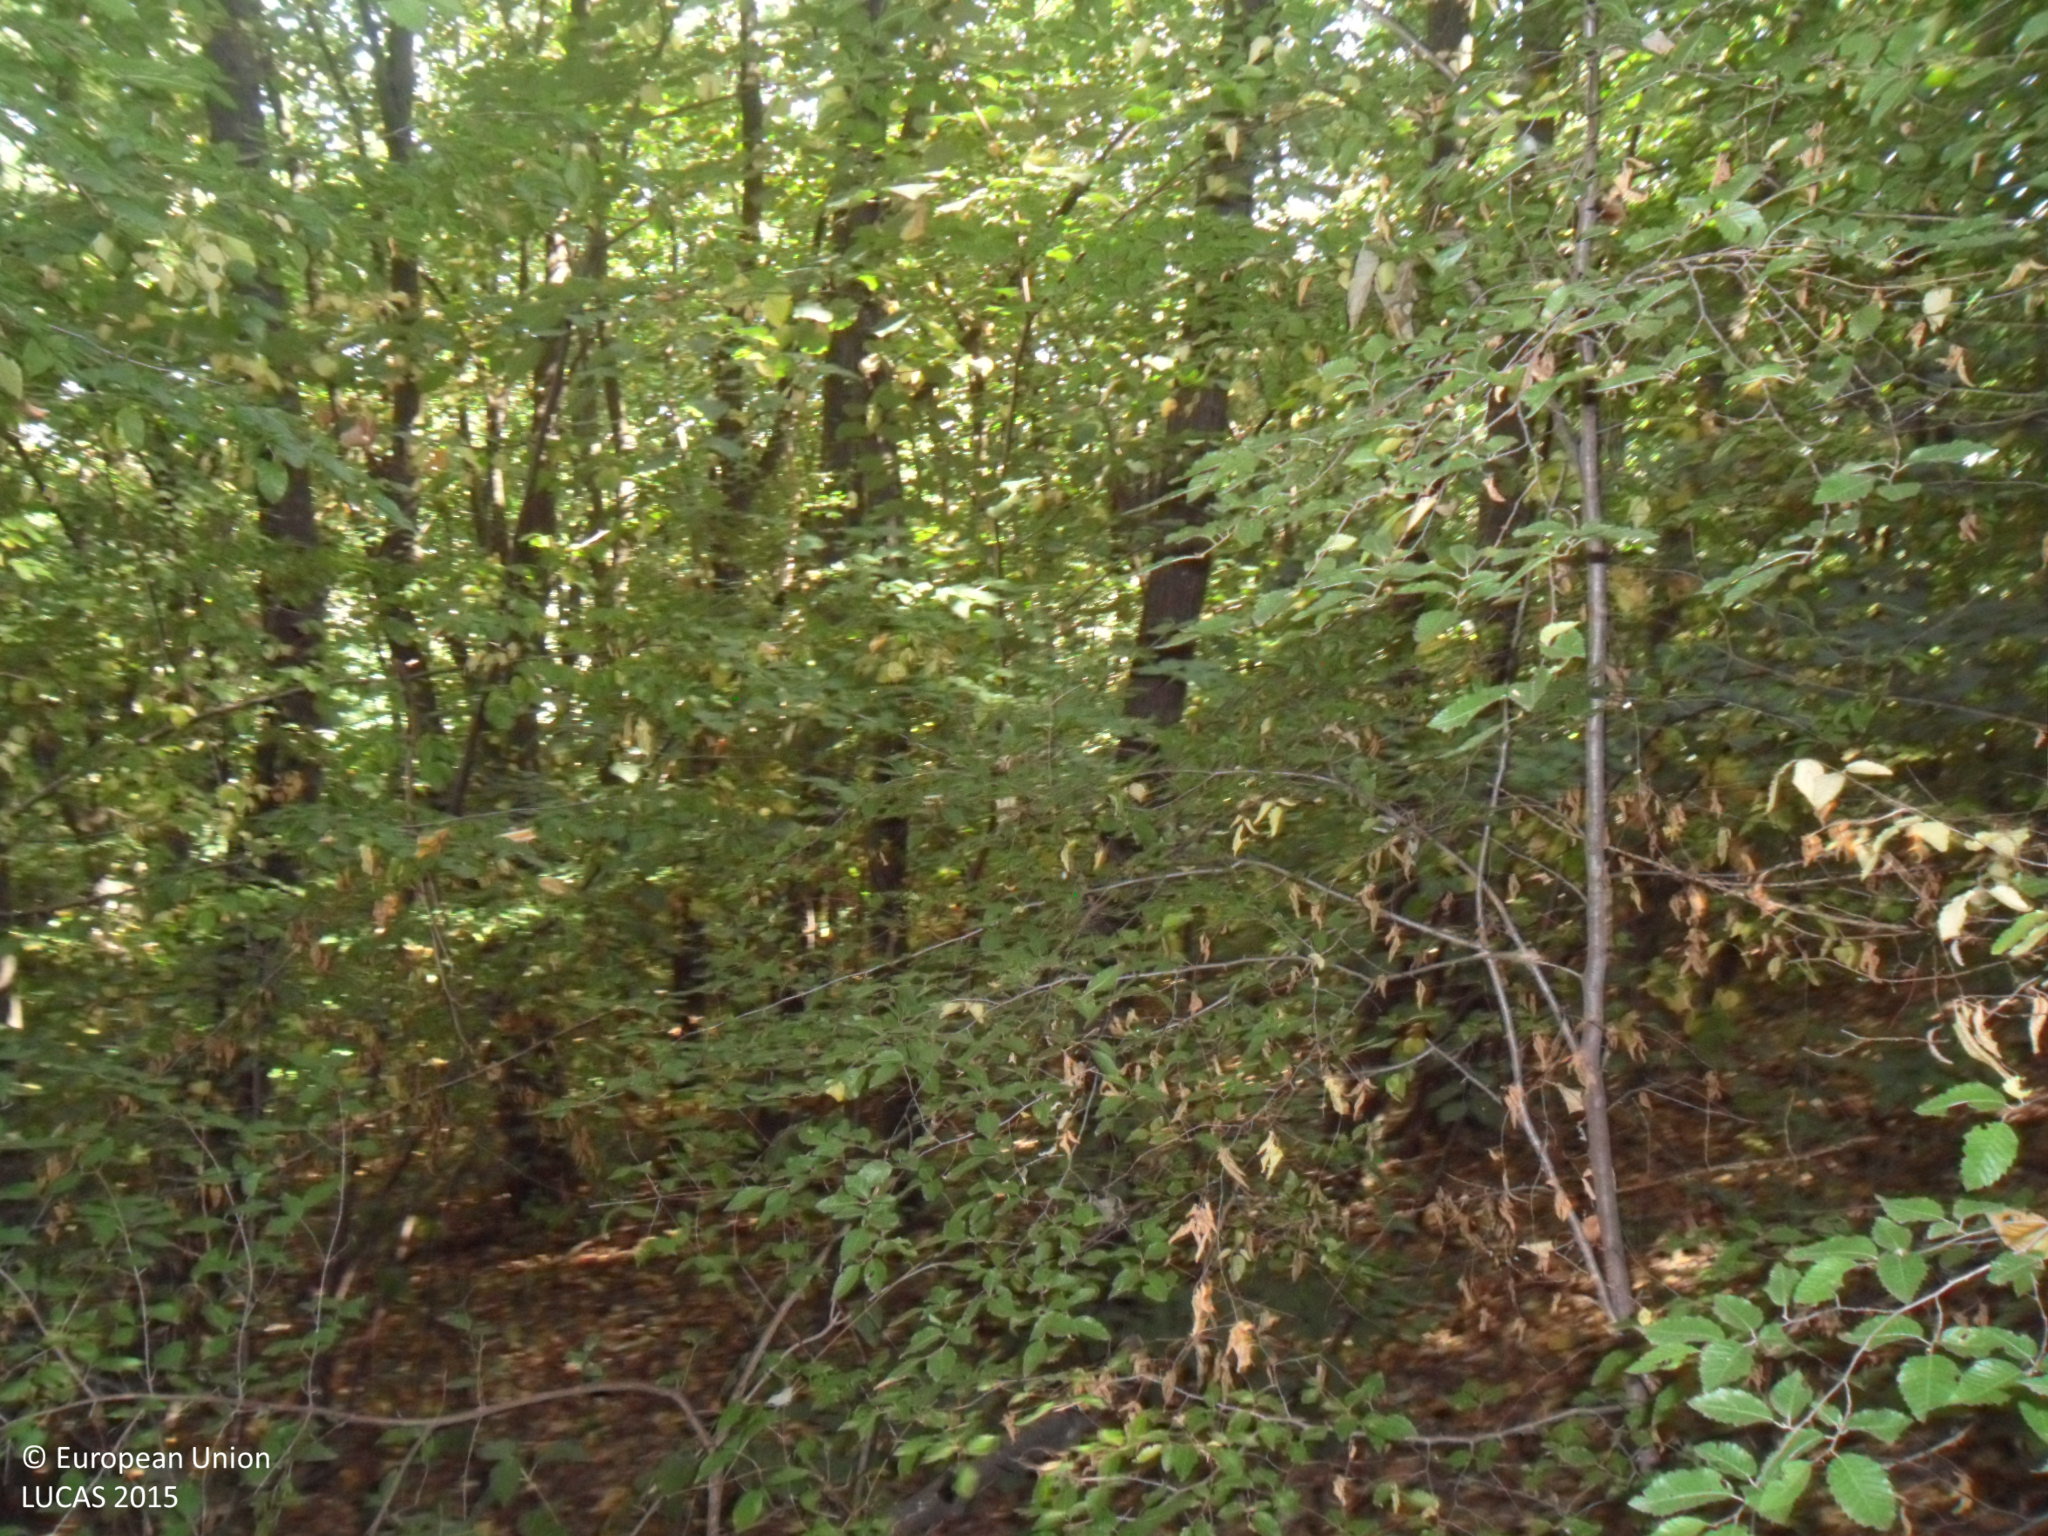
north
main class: Woodland
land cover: Broadleaved woodland
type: beech forest
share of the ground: > 75 %
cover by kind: broadleaved forest trees 100 %
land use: Forestry
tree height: > 5 m
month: July
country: BG
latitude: 43.3250
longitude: 26.8710
